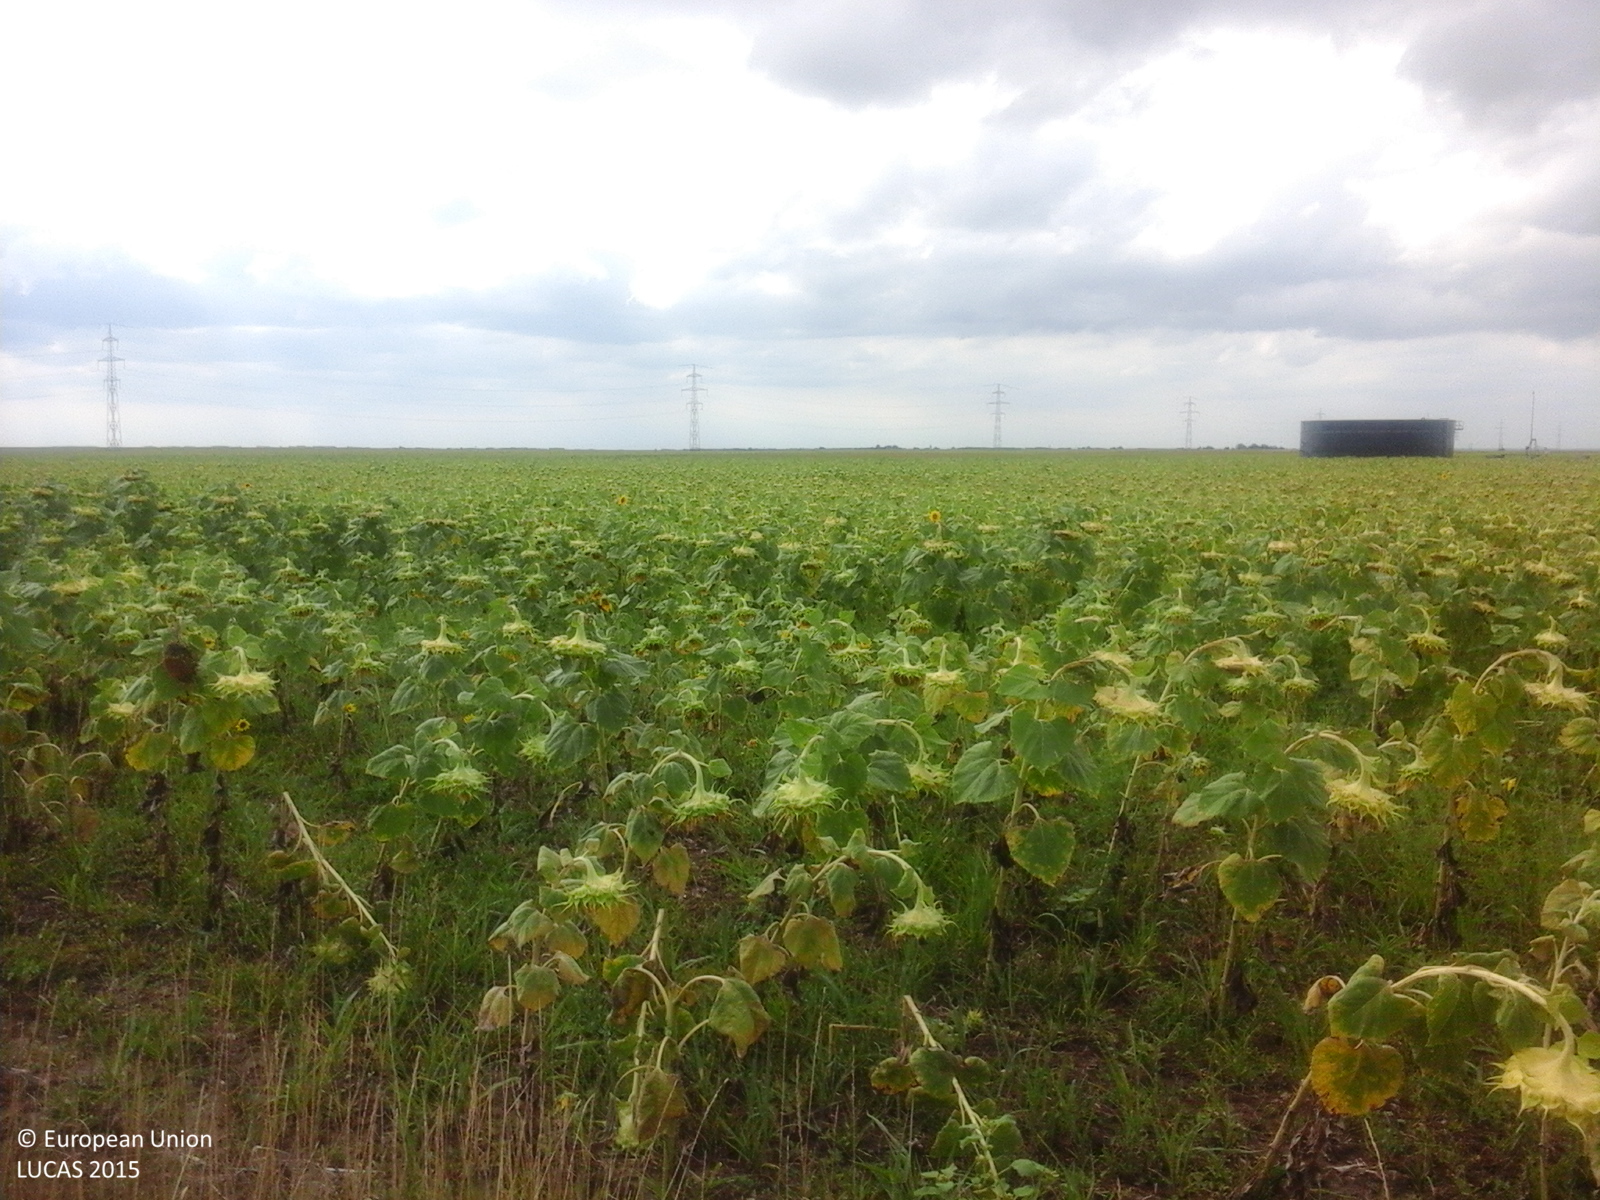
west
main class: Cropland
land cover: Sunflower
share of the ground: > 75 %
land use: Agriculture (excluding fallow land and kitchen gardens)
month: August
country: RO
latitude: 45.5528
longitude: 21.4453
